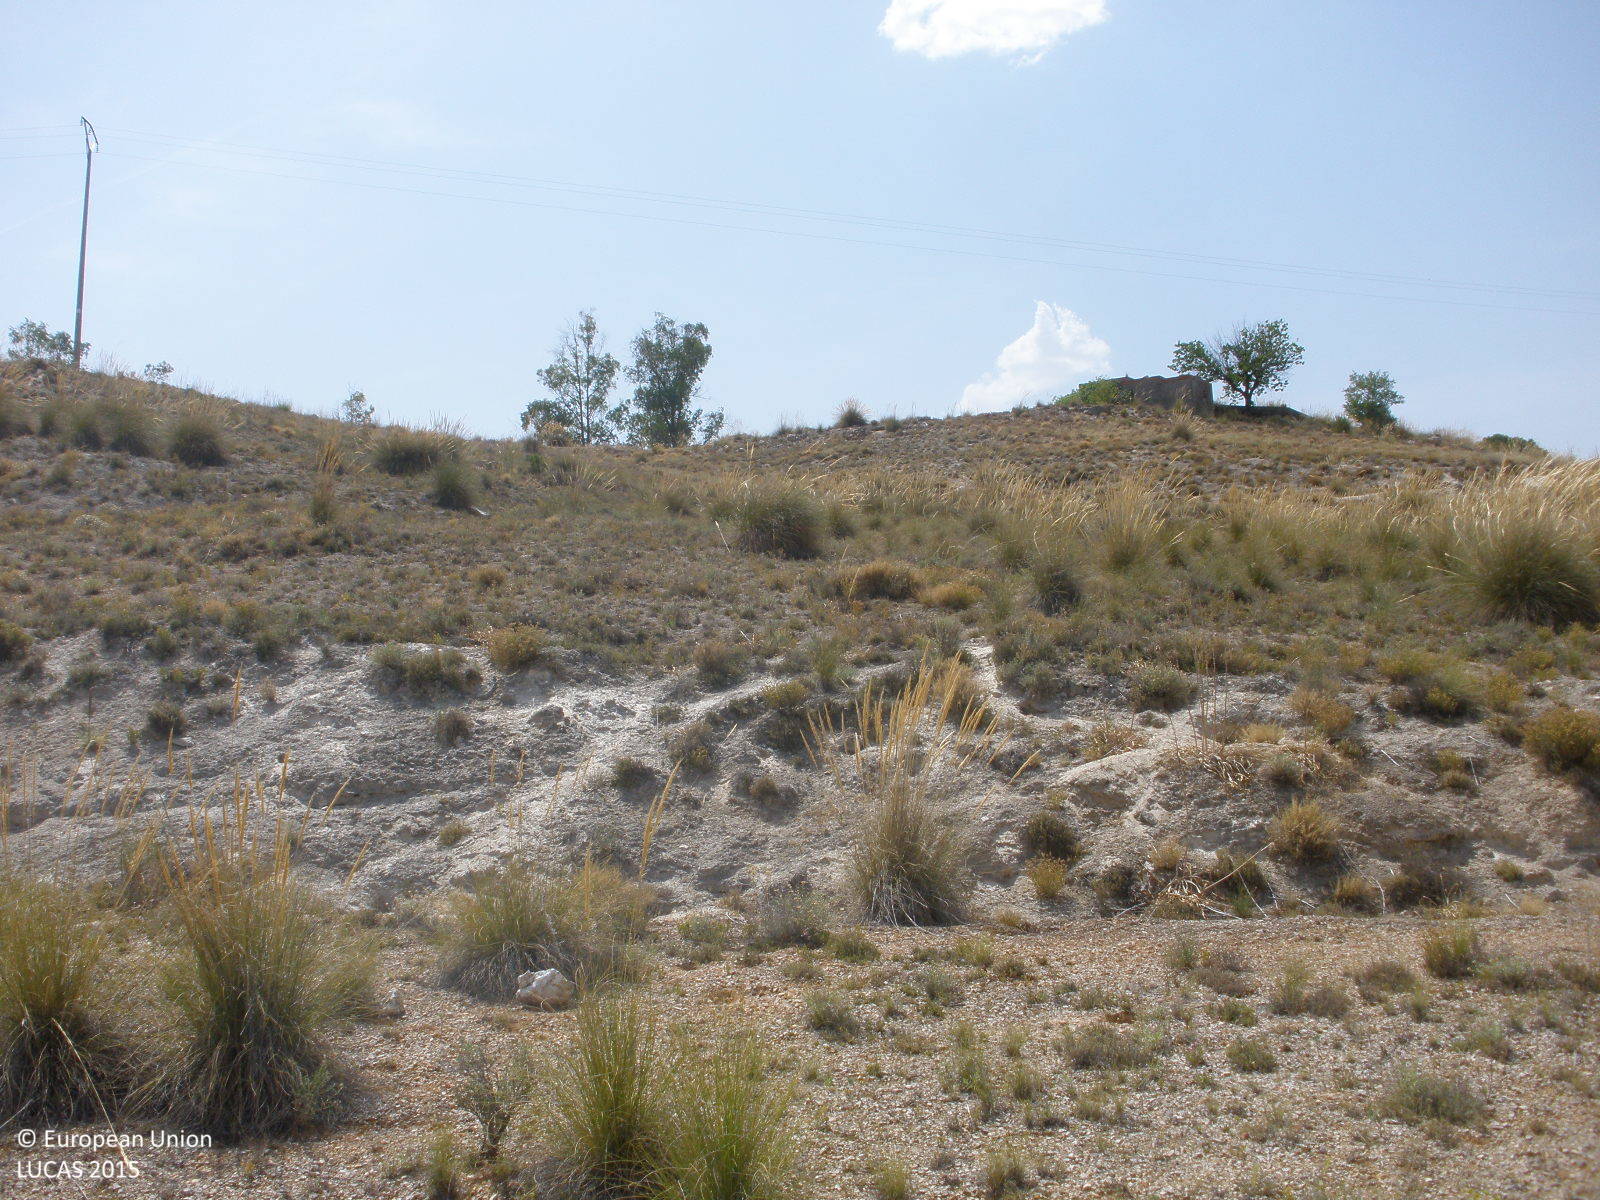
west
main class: Shrubland
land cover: Shrubland without tree cover
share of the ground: 10 - 25 %
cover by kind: herbaceous plants 70 %, shrubs 15 %, consolidated bare surface 15 %
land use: Semi-natural and natural areas not in use
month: July
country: ES
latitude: 40.1815
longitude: -3.4314
